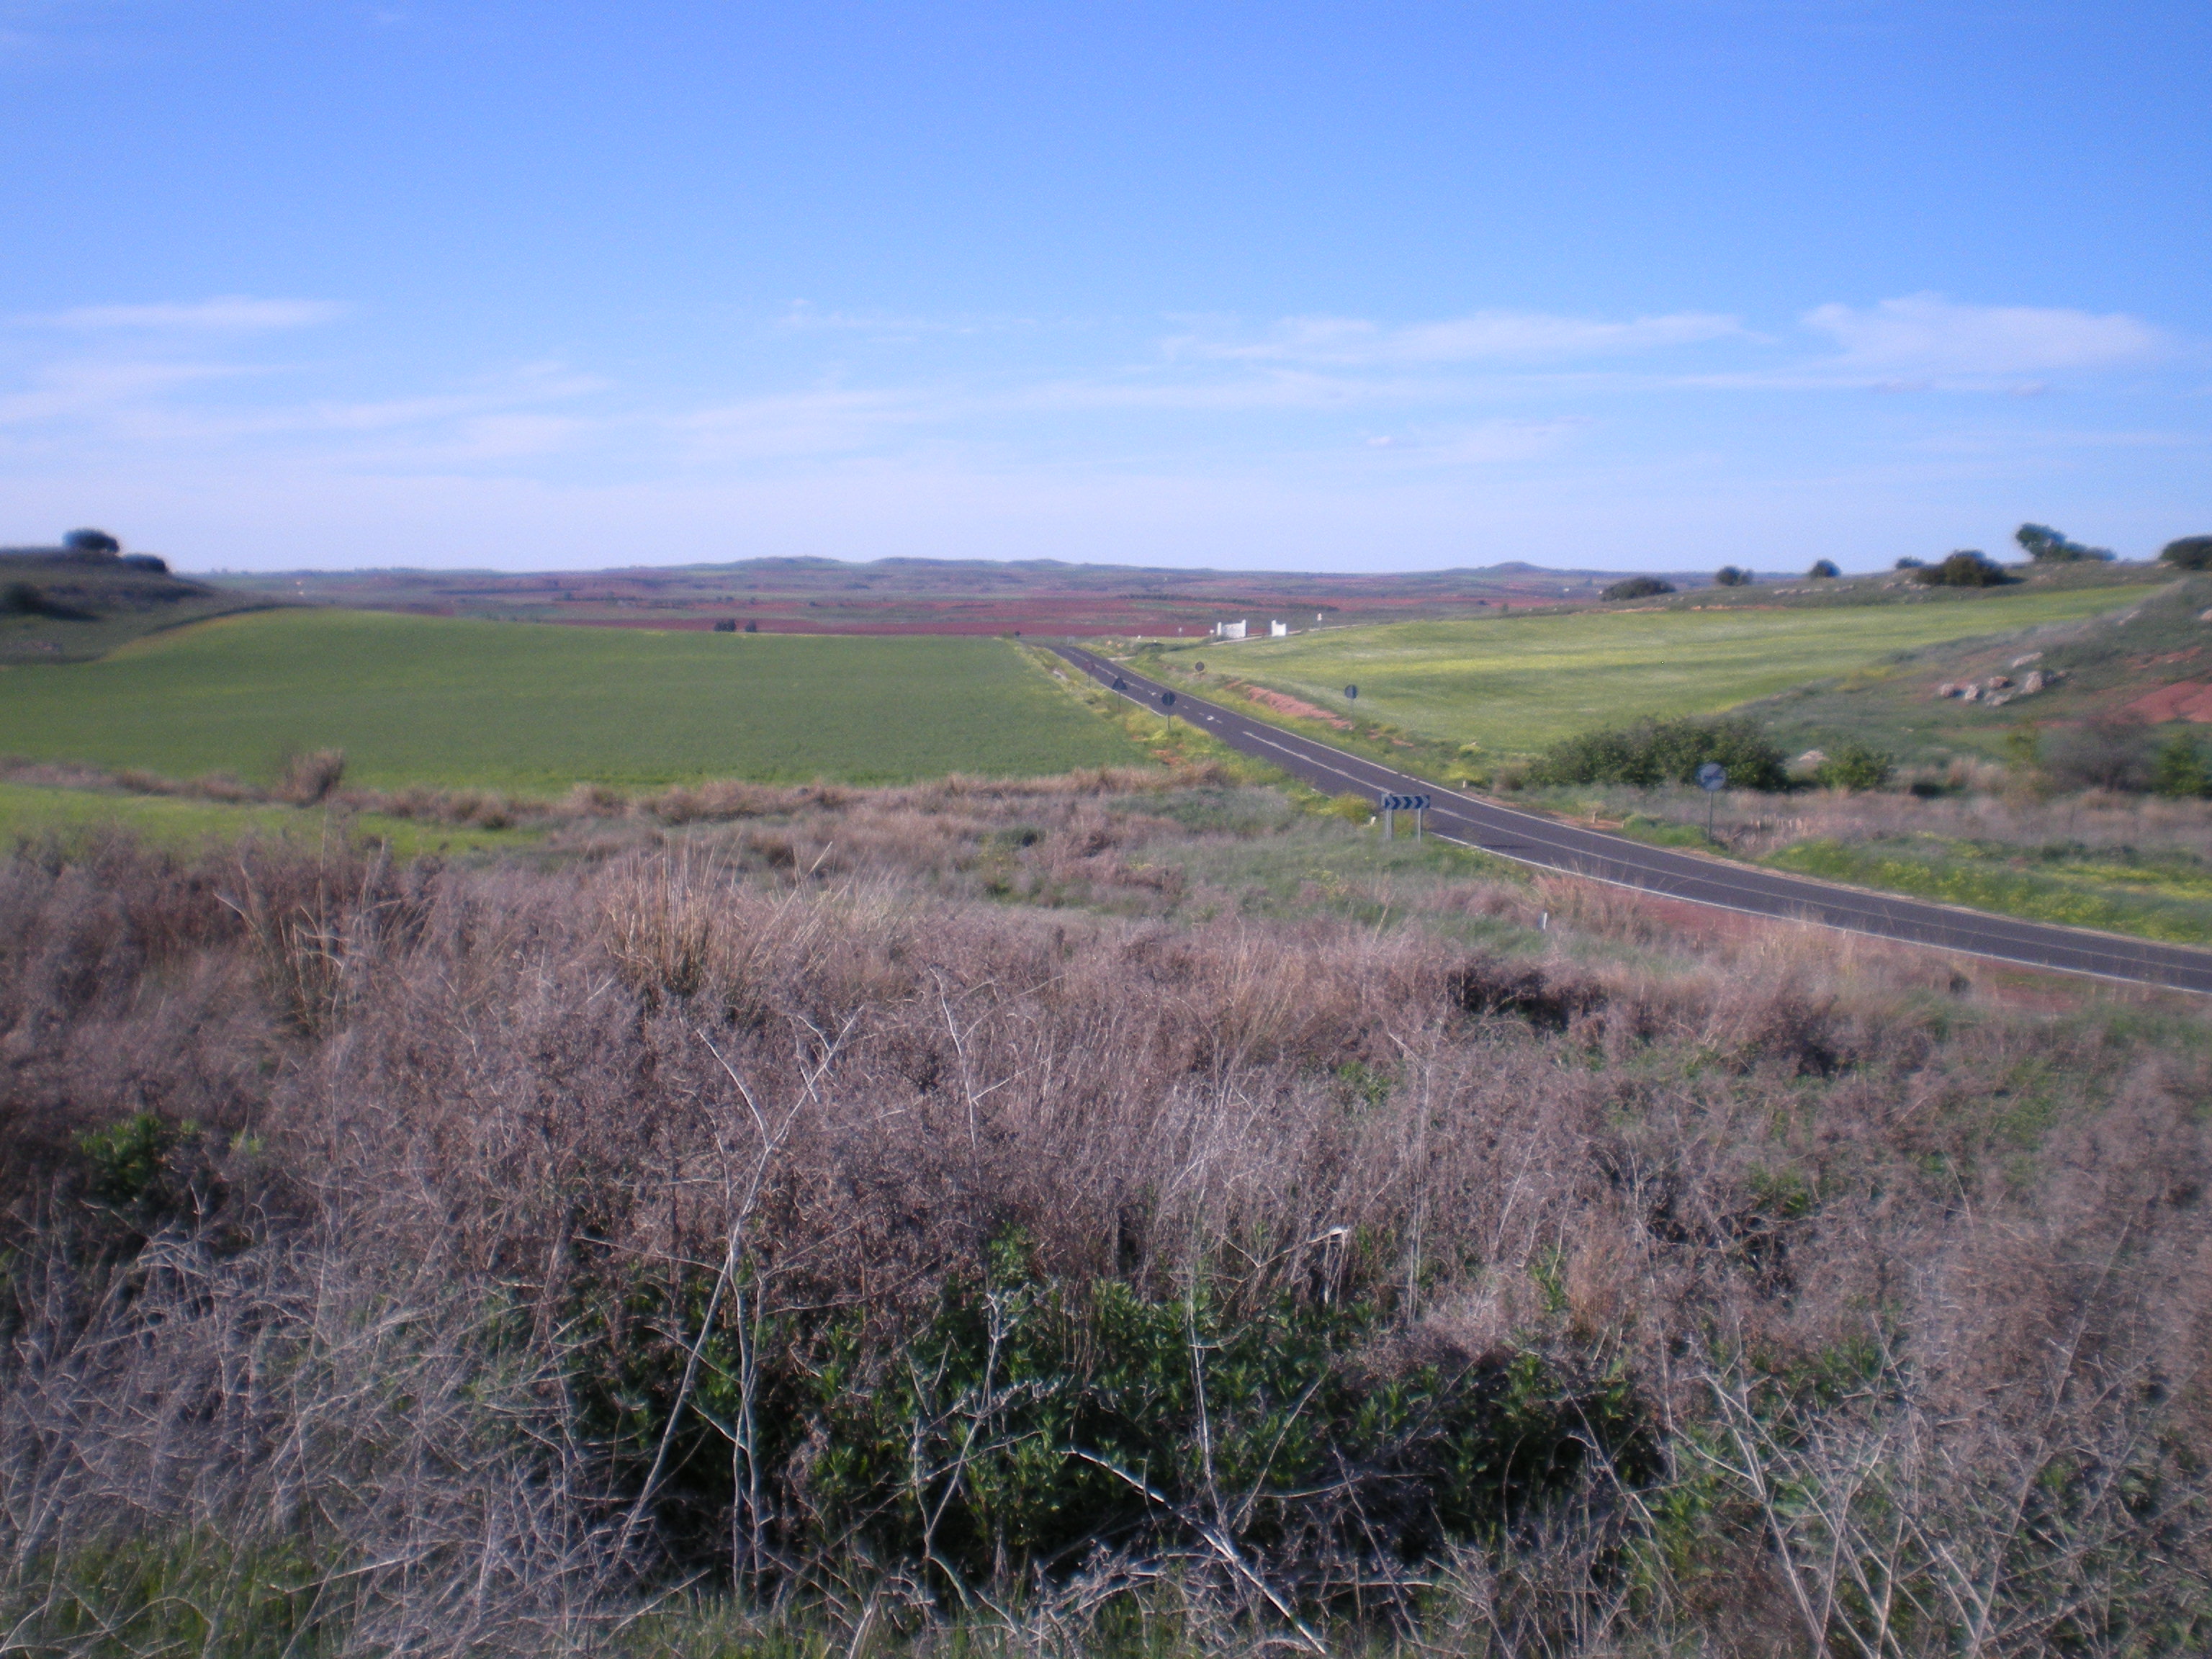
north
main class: Grassland
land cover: Spontaneously vegetated surfaces
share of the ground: > 75 %
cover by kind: herbaceous plants 80 %, unconsolidated bare surface 20 %
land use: Fallow land
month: April
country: ES
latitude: 38.6685
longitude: -2.9815
